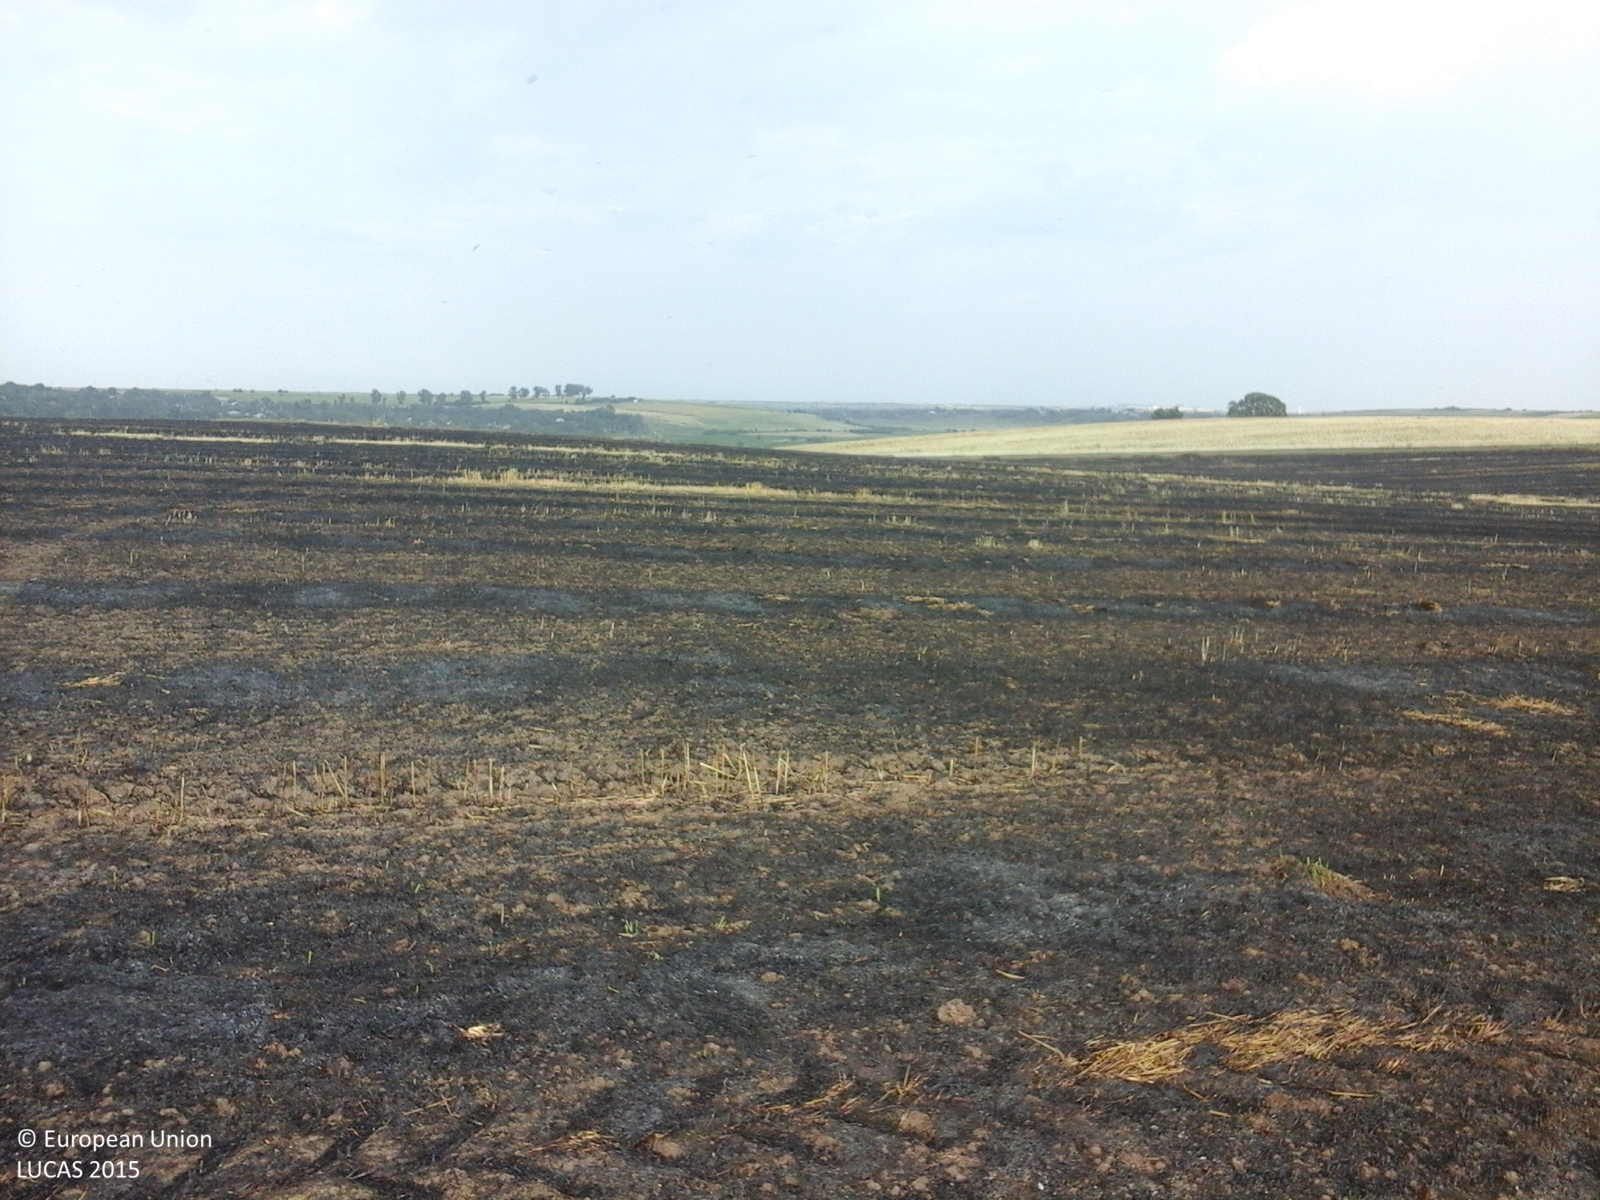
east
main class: Cropland
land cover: Common wheat
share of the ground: < 10 %
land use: Agriculture (excluding fallow land and kitchen gardens)
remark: Burnt area
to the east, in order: Common wheat; Tracks; Rape and turnip rape
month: July
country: RO
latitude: 43.9507
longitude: 24.8637
